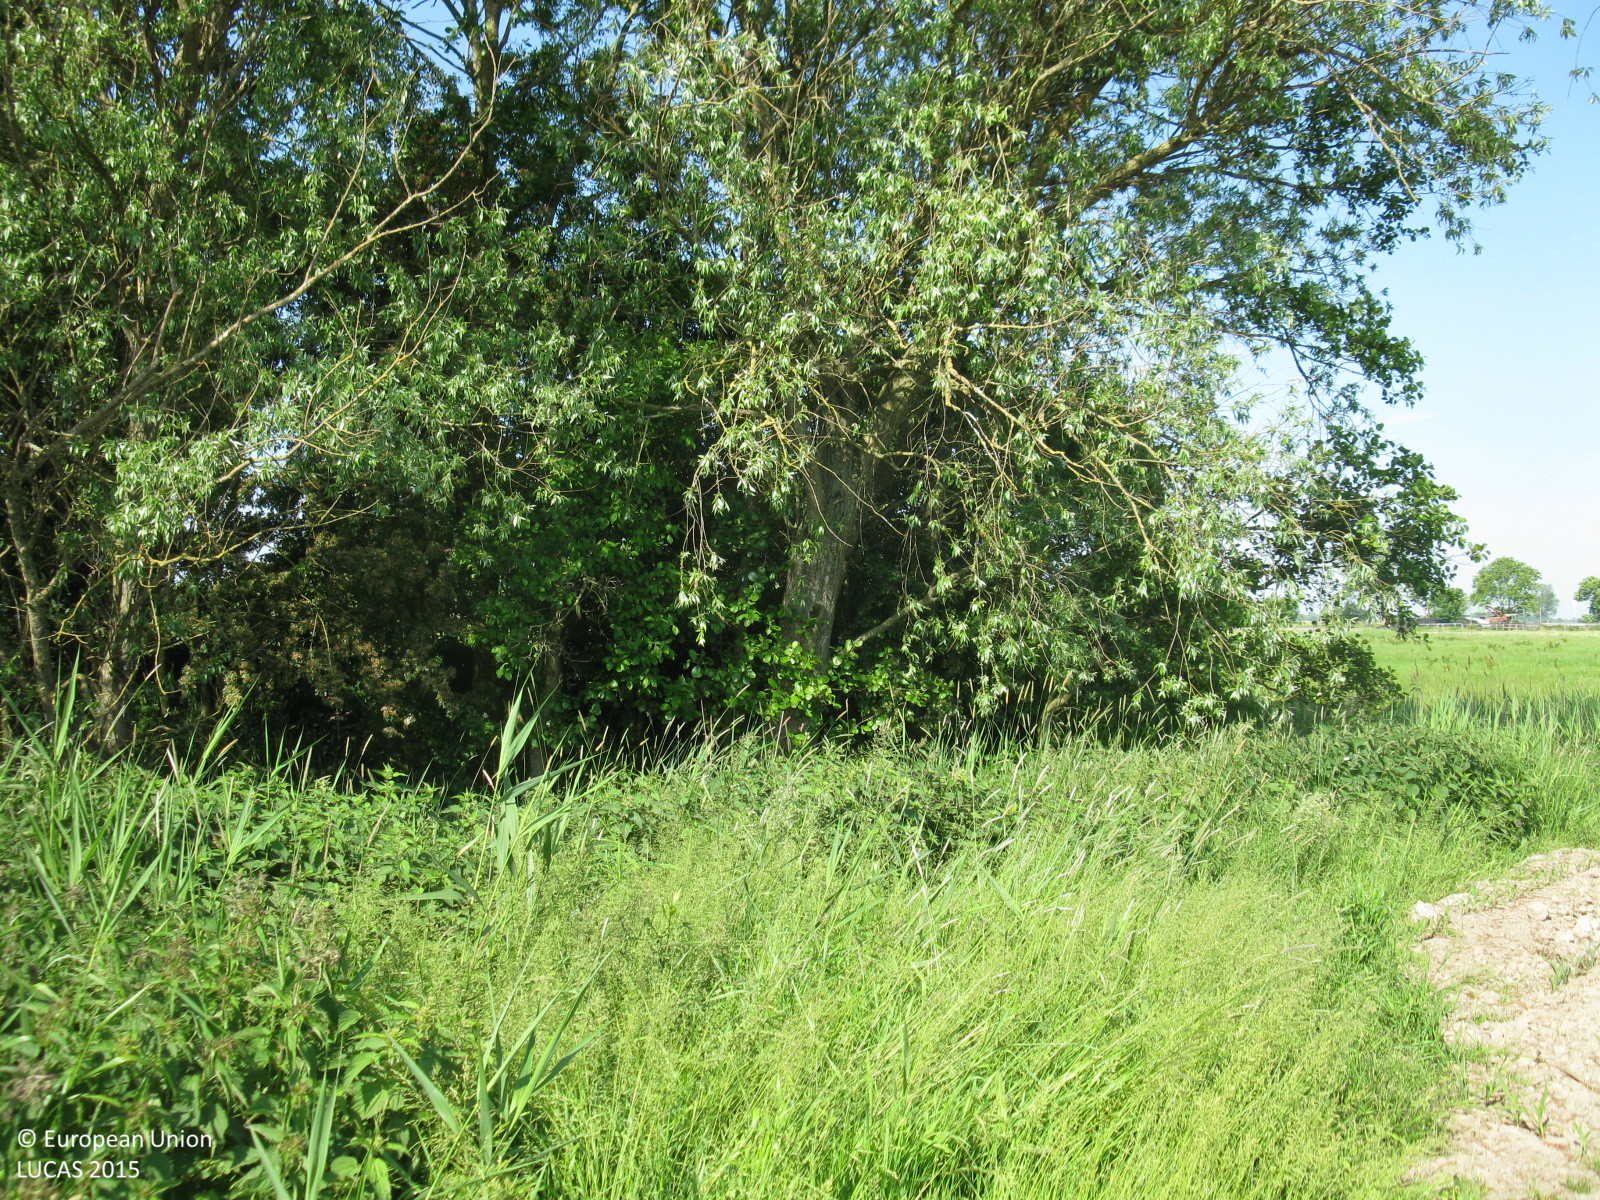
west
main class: Grassland
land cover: Grassland without tree/shrub cover
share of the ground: > 75 %
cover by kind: herbaceous plants 100 %
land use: Agriculture (excluding fallow land and kitchen gardens)
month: June
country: DE
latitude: 53.5358
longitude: 8.4466
